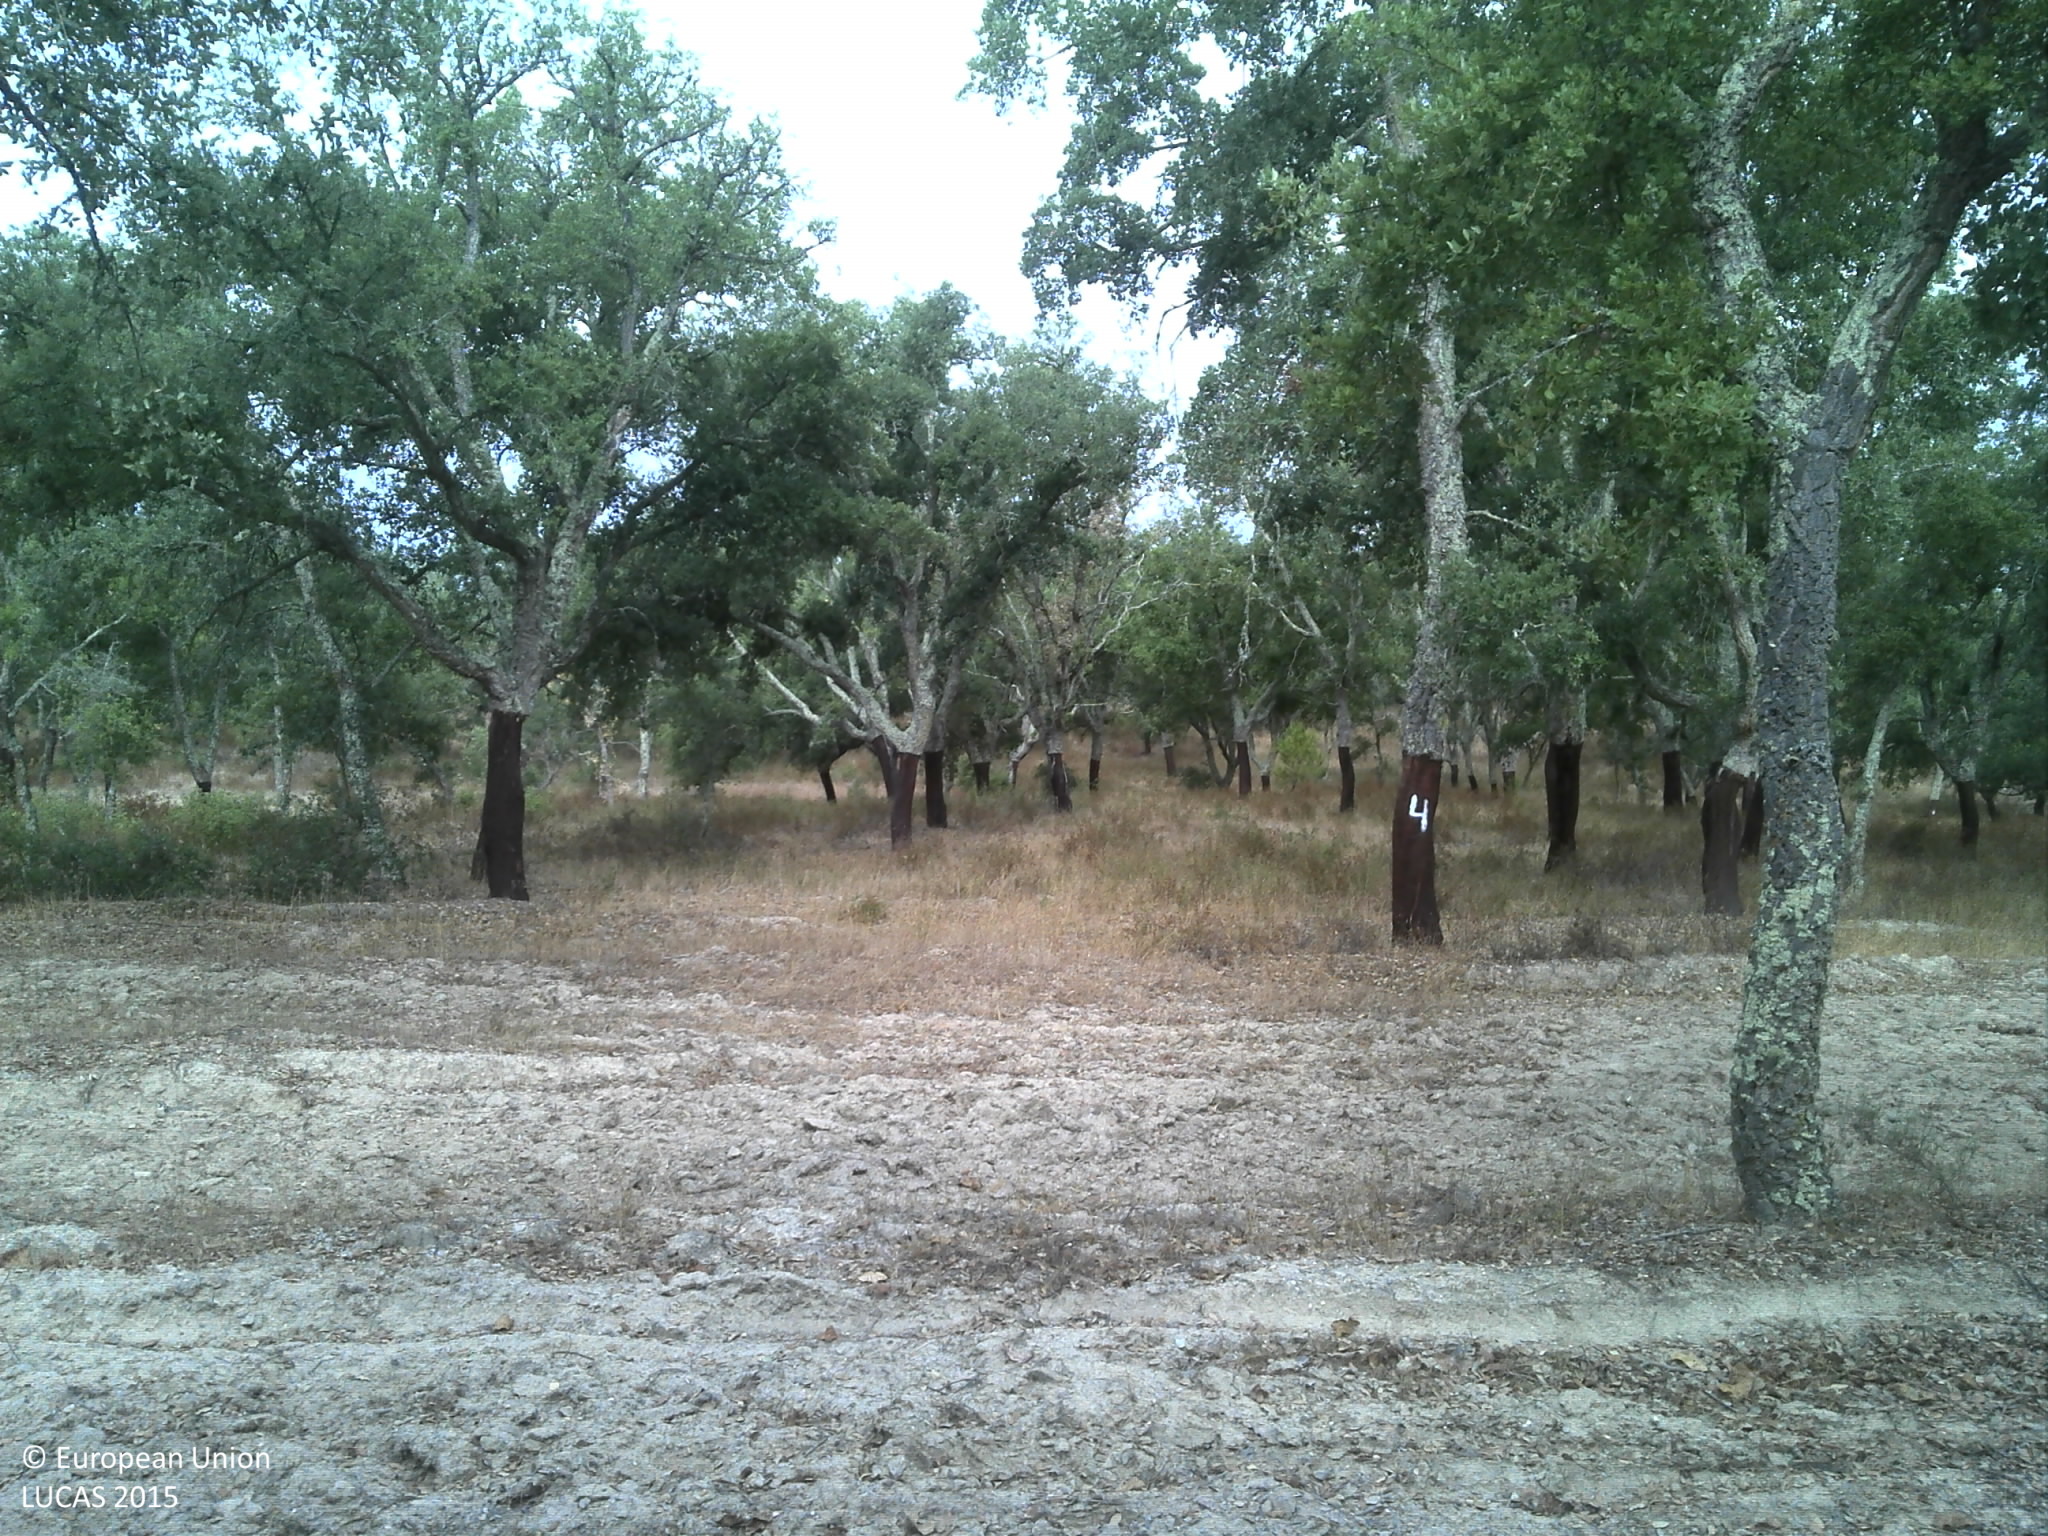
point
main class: Woodland
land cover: Broadleaved woodland
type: broadleaved evergreen forest
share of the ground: 50 - 75 %
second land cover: Grassland without tree/shrub cover
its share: 25 - 50 %
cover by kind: broadleaved forest trees 60 %, herbaceous plants 30 %, unconsolidated bare surface 10 %
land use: Forestry
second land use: Agriculture (excluding fallow land and kitchen gardens)
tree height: > 5 m
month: July
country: PT
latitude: 38.9200
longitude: -8.6698
